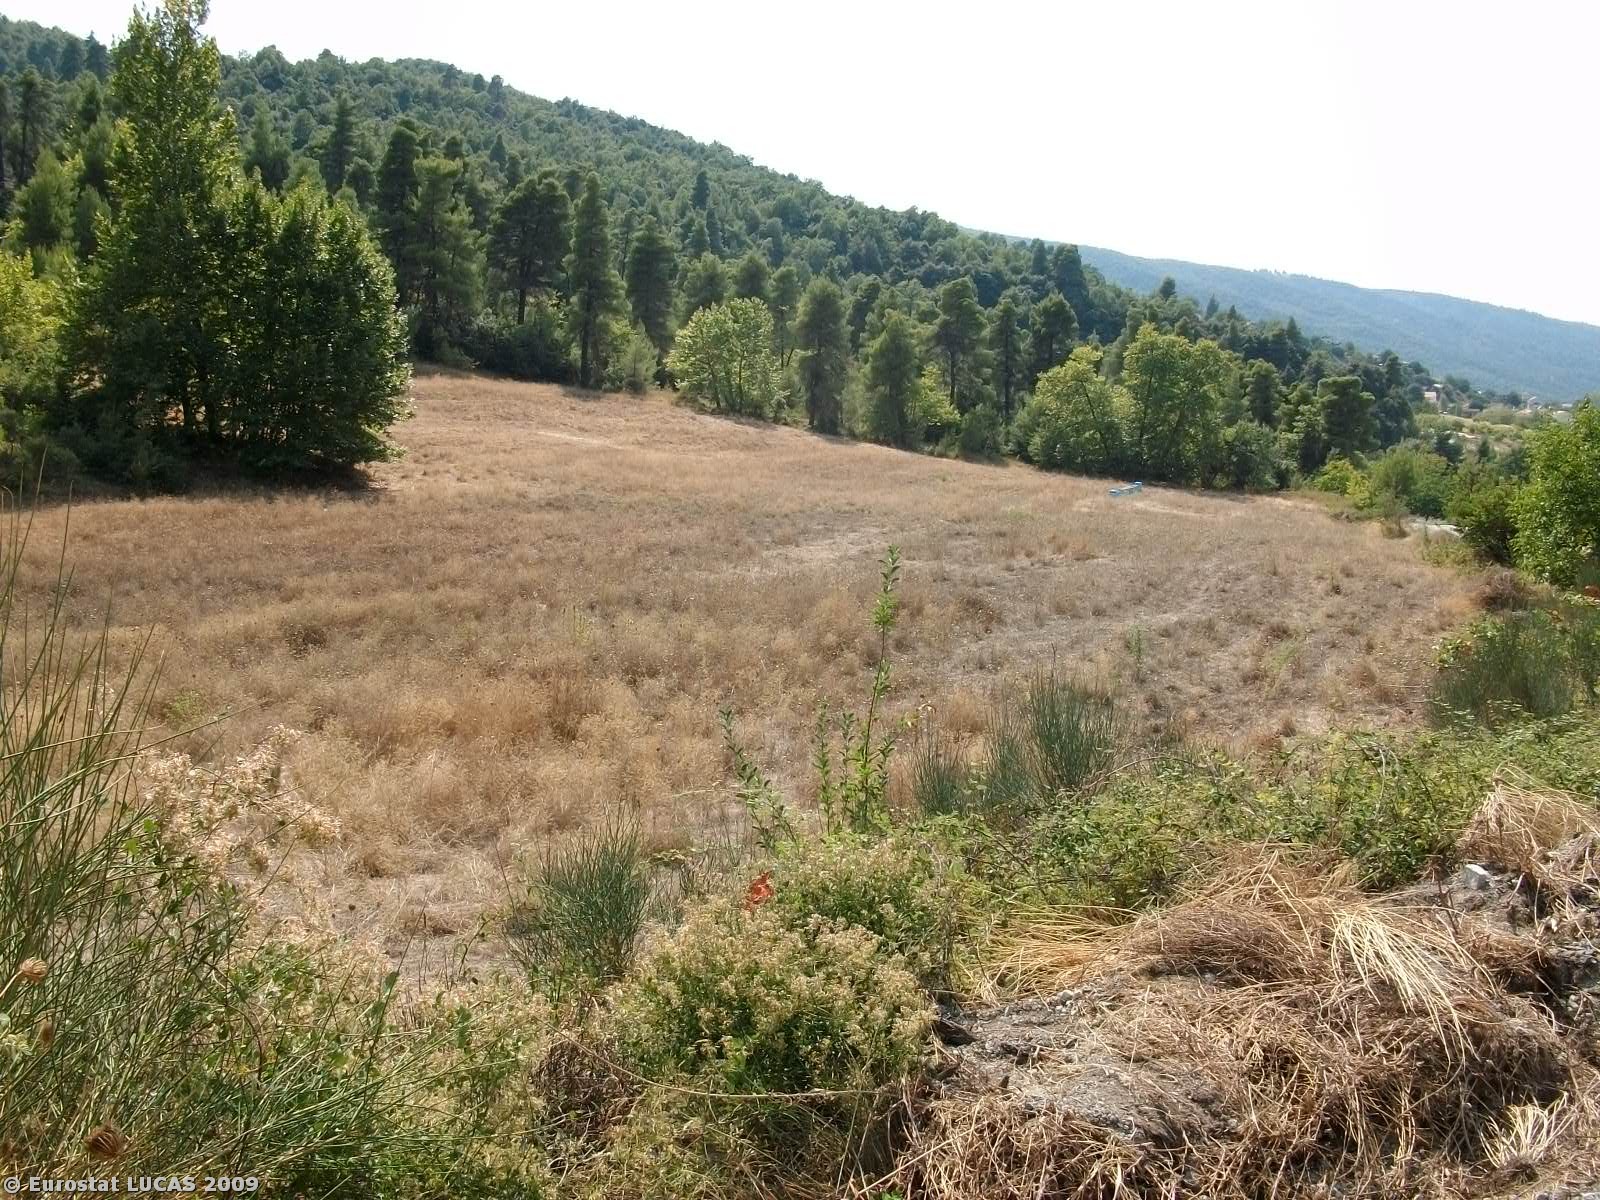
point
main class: Shrubland
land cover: Shrubland without tree cover
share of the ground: 25 - 50 %
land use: Fallow land
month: August
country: GR
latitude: 38.8995
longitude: 23.1668
